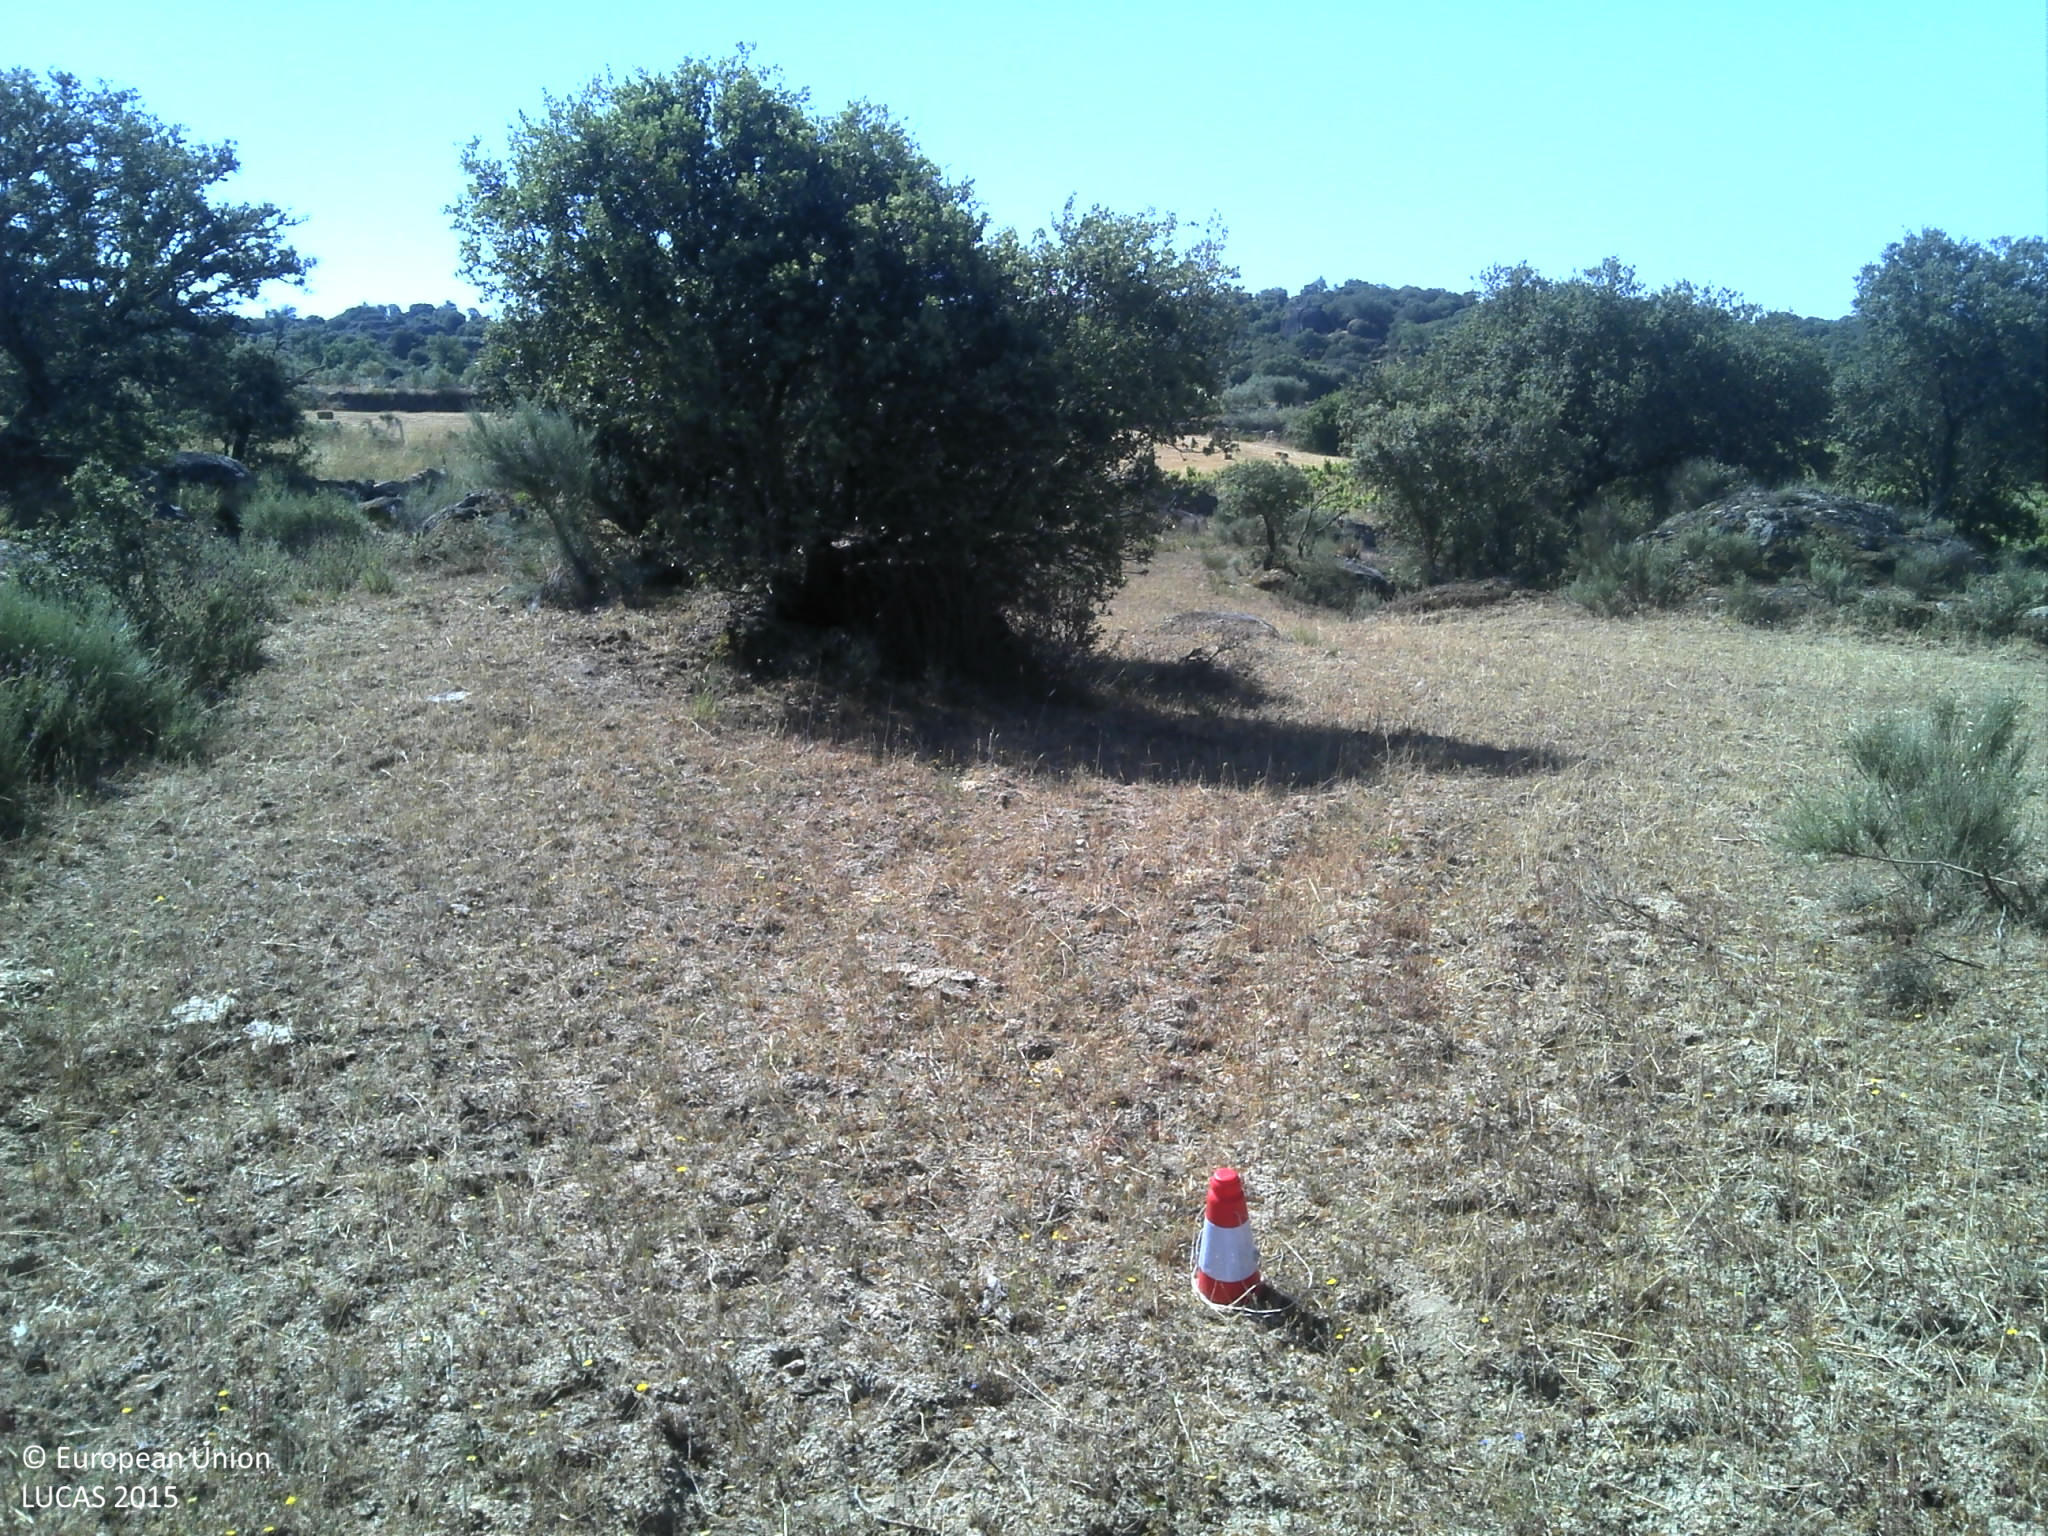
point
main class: Grassland
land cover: Grassland with sparse tree/shrub cover
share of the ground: 50 - 75 %
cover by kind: unconsolidated bare surface 50 %, herbaceous plants 40 %, broadleaved forest trees 5 %, shrubs 5 %
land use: Agriculture (excluding fallow land and kitchen gardens)
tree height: > 5 m
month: June
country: PT
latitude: 40.6516
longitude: -7.0013
